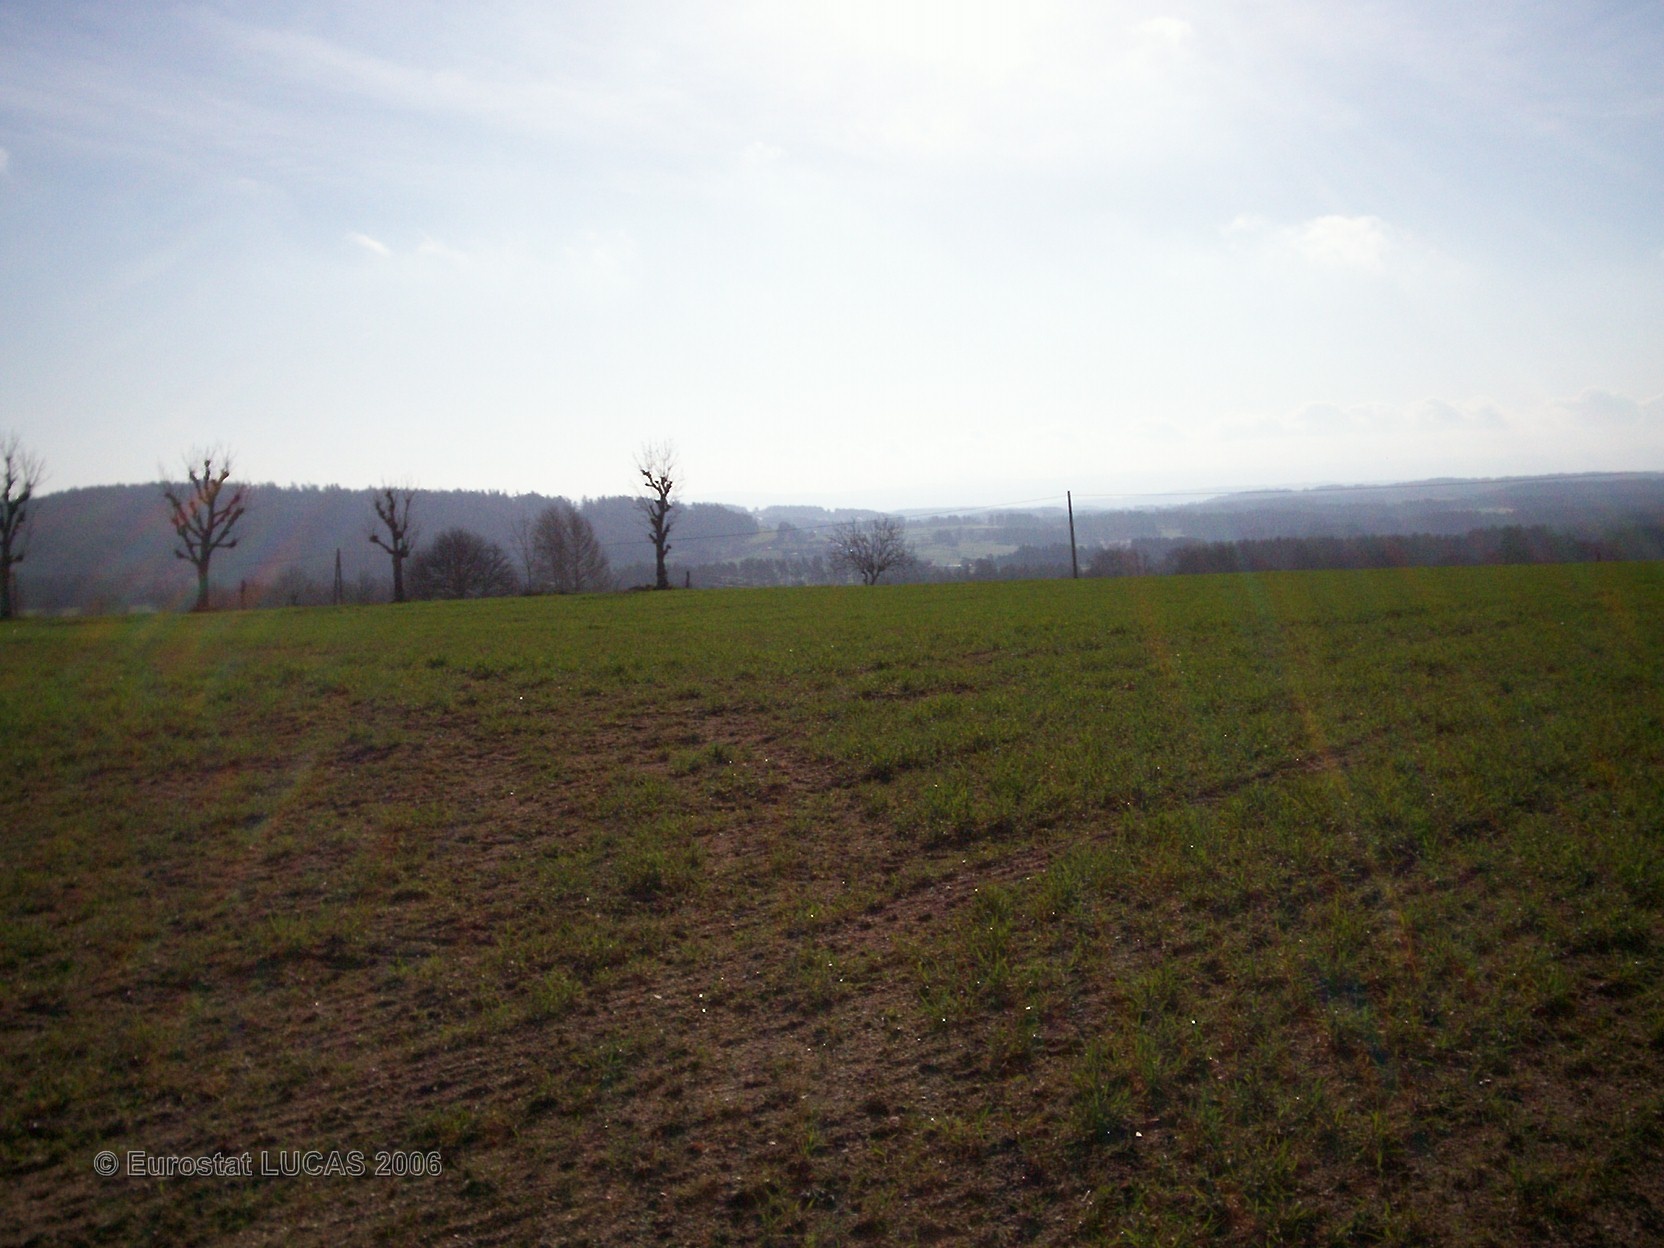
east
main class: Cropland
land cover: Rye
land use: Agriculture (excluding fallow land and kitchen gardens)
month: April
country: FR
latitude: 44.8320
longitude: 3.1855
